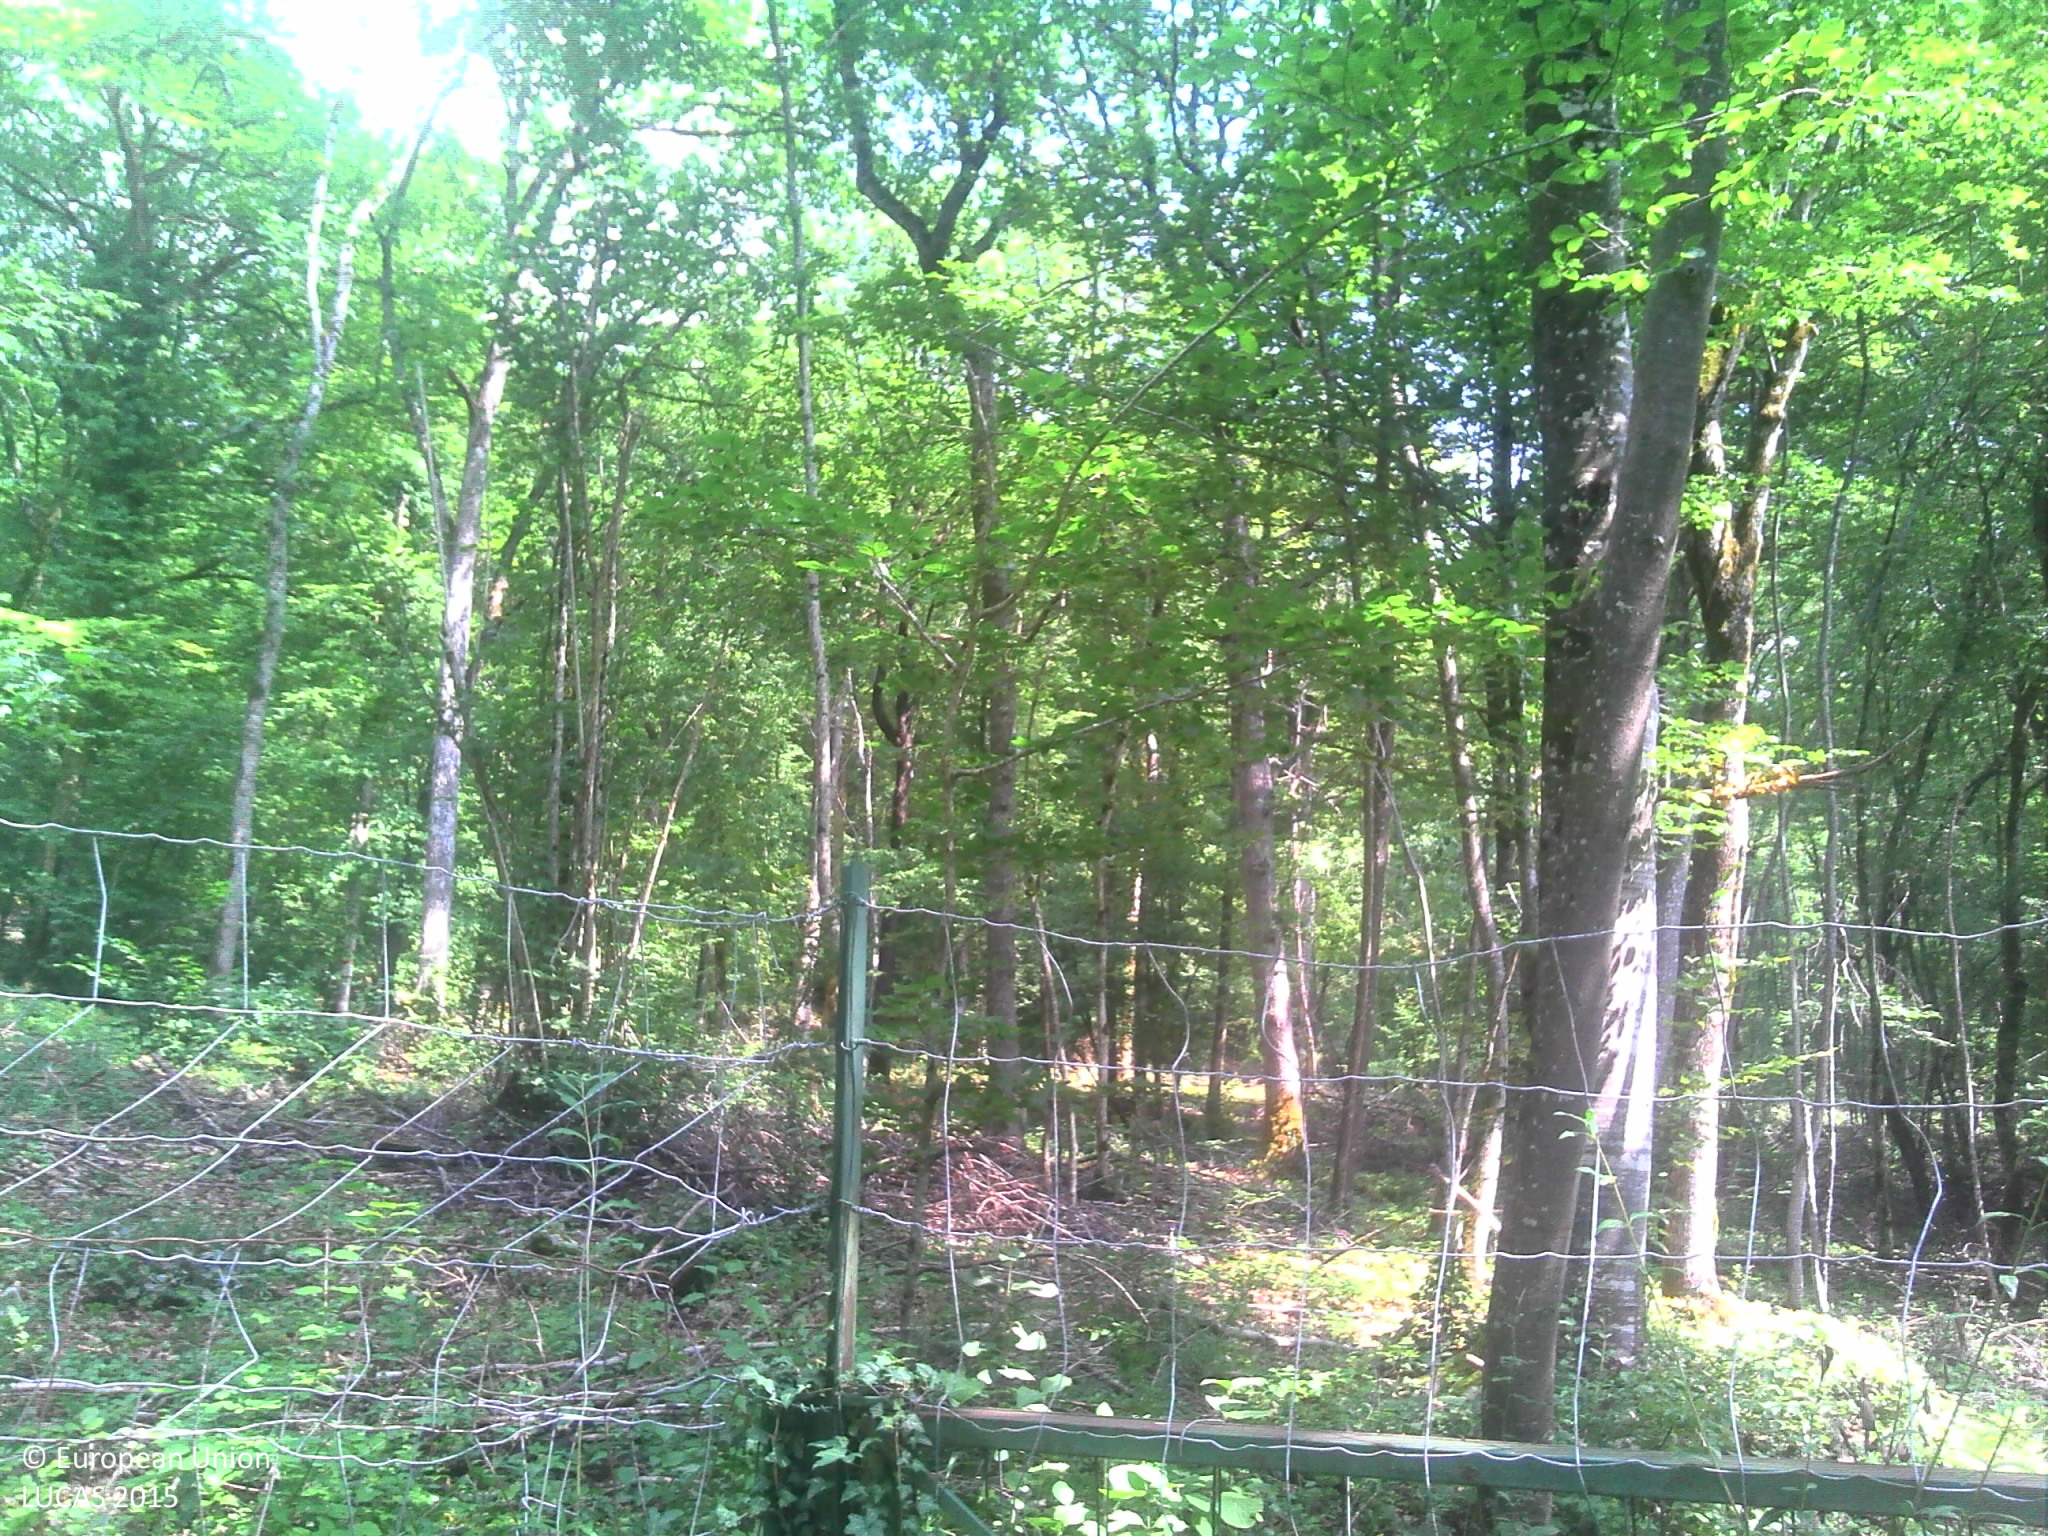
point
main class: Woodland
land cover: Broadleaved woodland
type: mesophytic deciduous forest
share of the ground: > 75 %
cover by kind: broadleaved forest trees 80 %, herbaceous plants 10 %, lichens and mosses 10 %
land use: Forestry
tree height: > 5 m
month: August
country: FR
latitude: 47.8093
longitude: 5.1257
